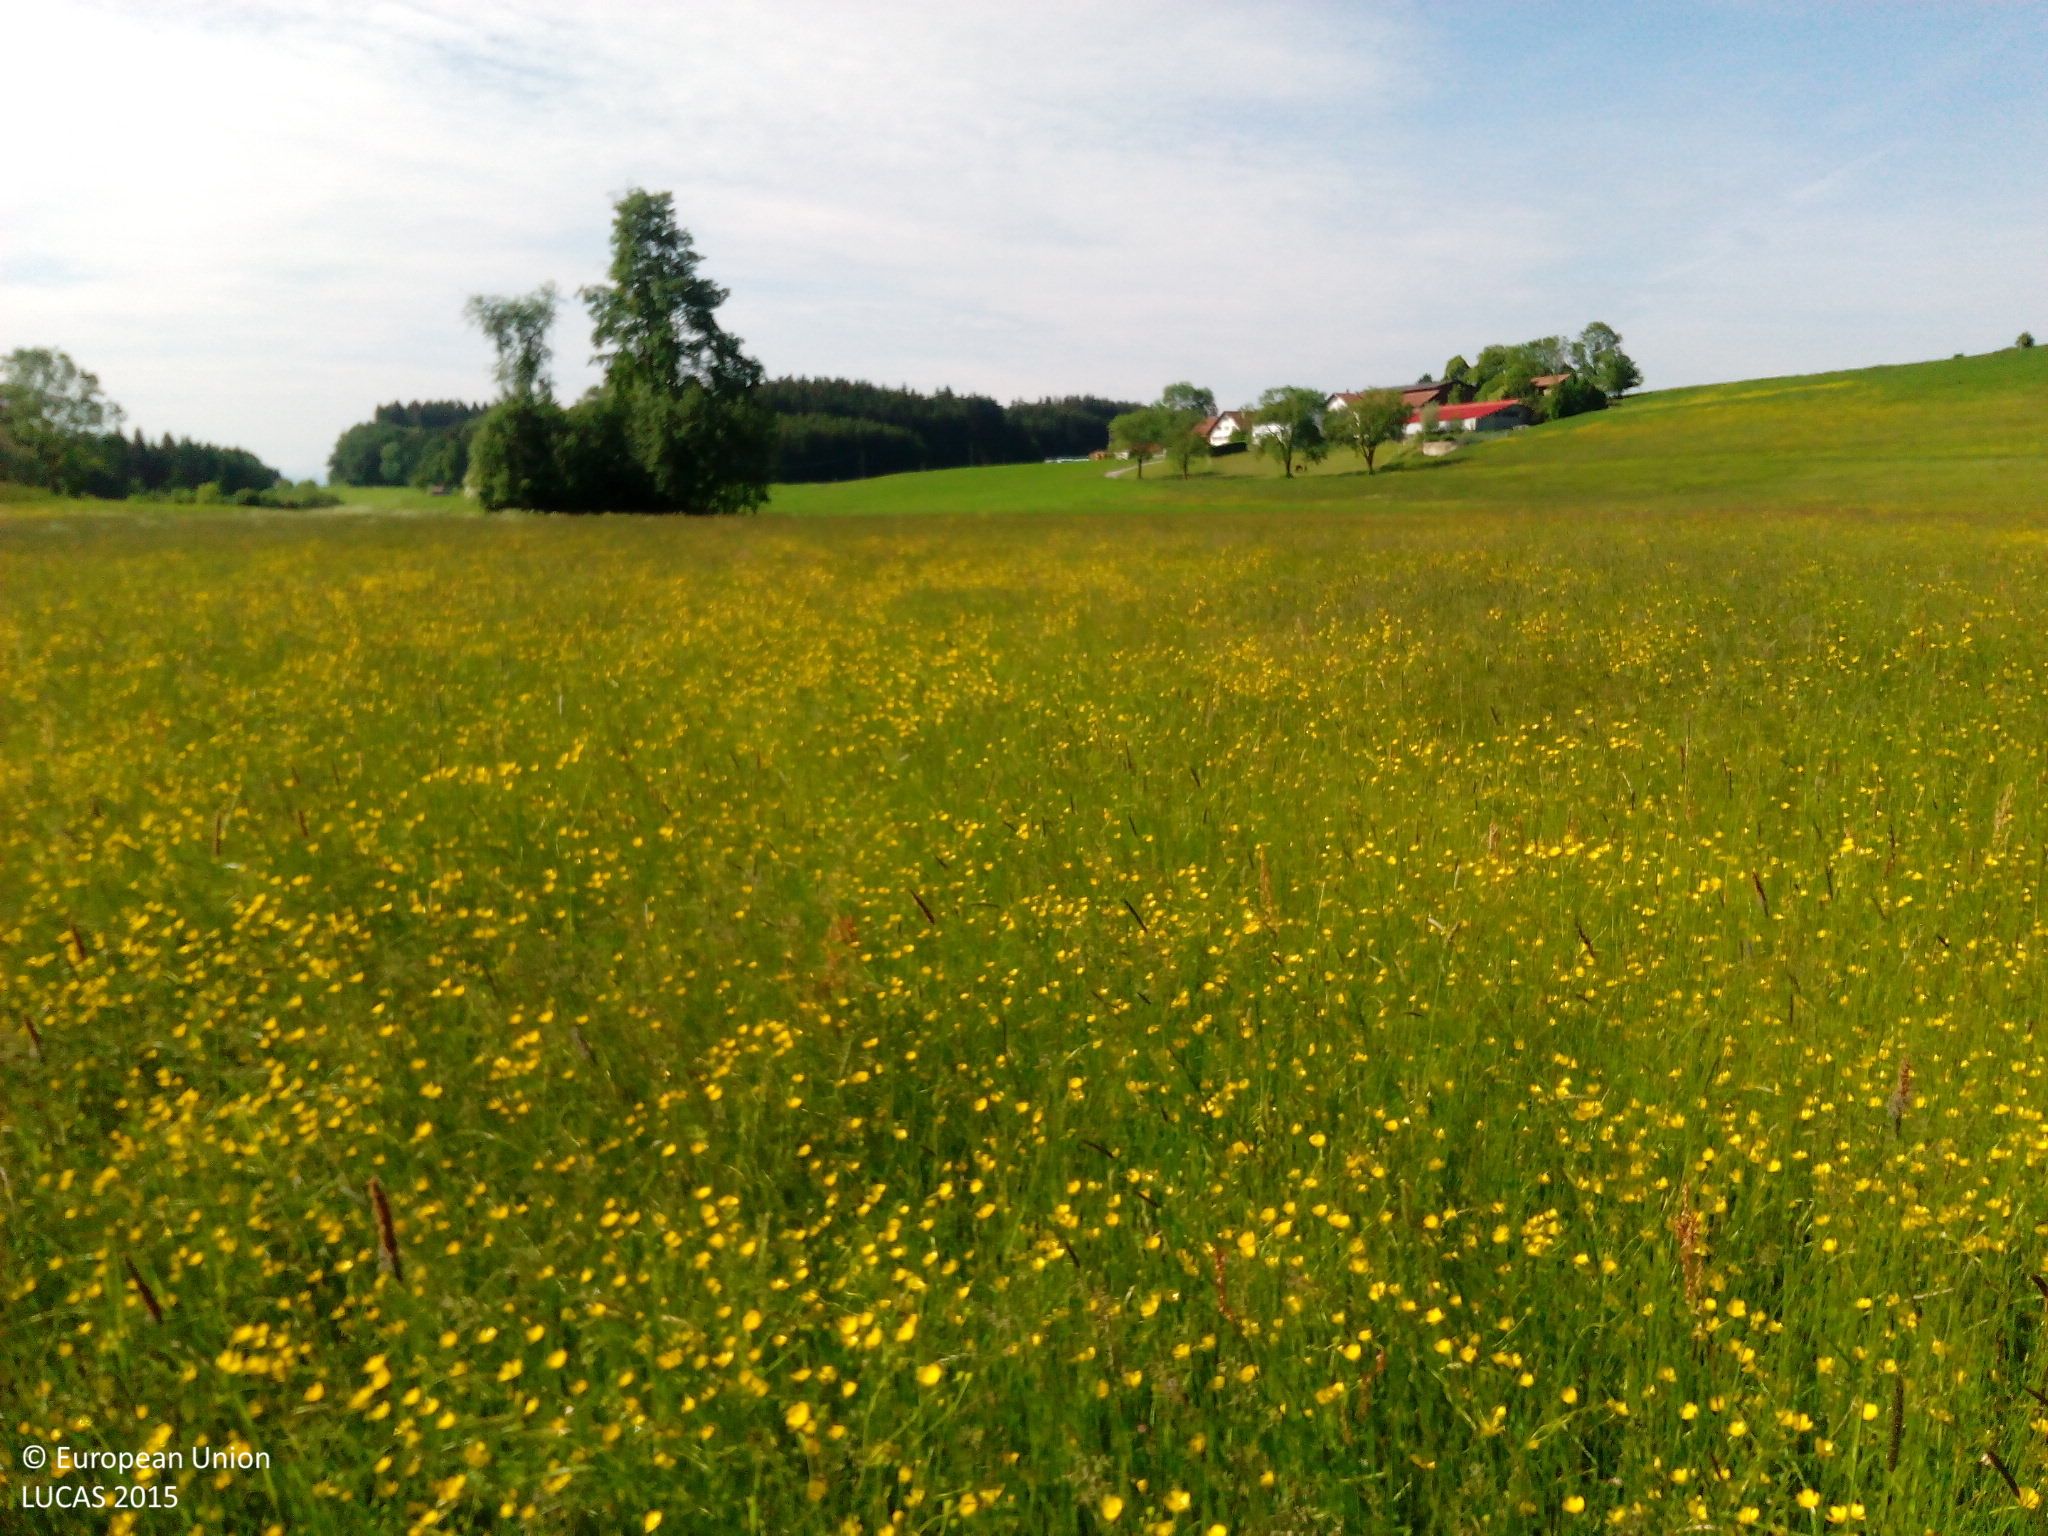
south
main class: Grassland
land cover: Grassland without tree/shrub cover
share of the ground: > 75 %
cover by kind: herbaceous plants 100 %
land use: Agriculture (excluding fallow land and kitchen gardens)
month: June
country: DE
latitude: 47.8453
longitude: 10.2537
